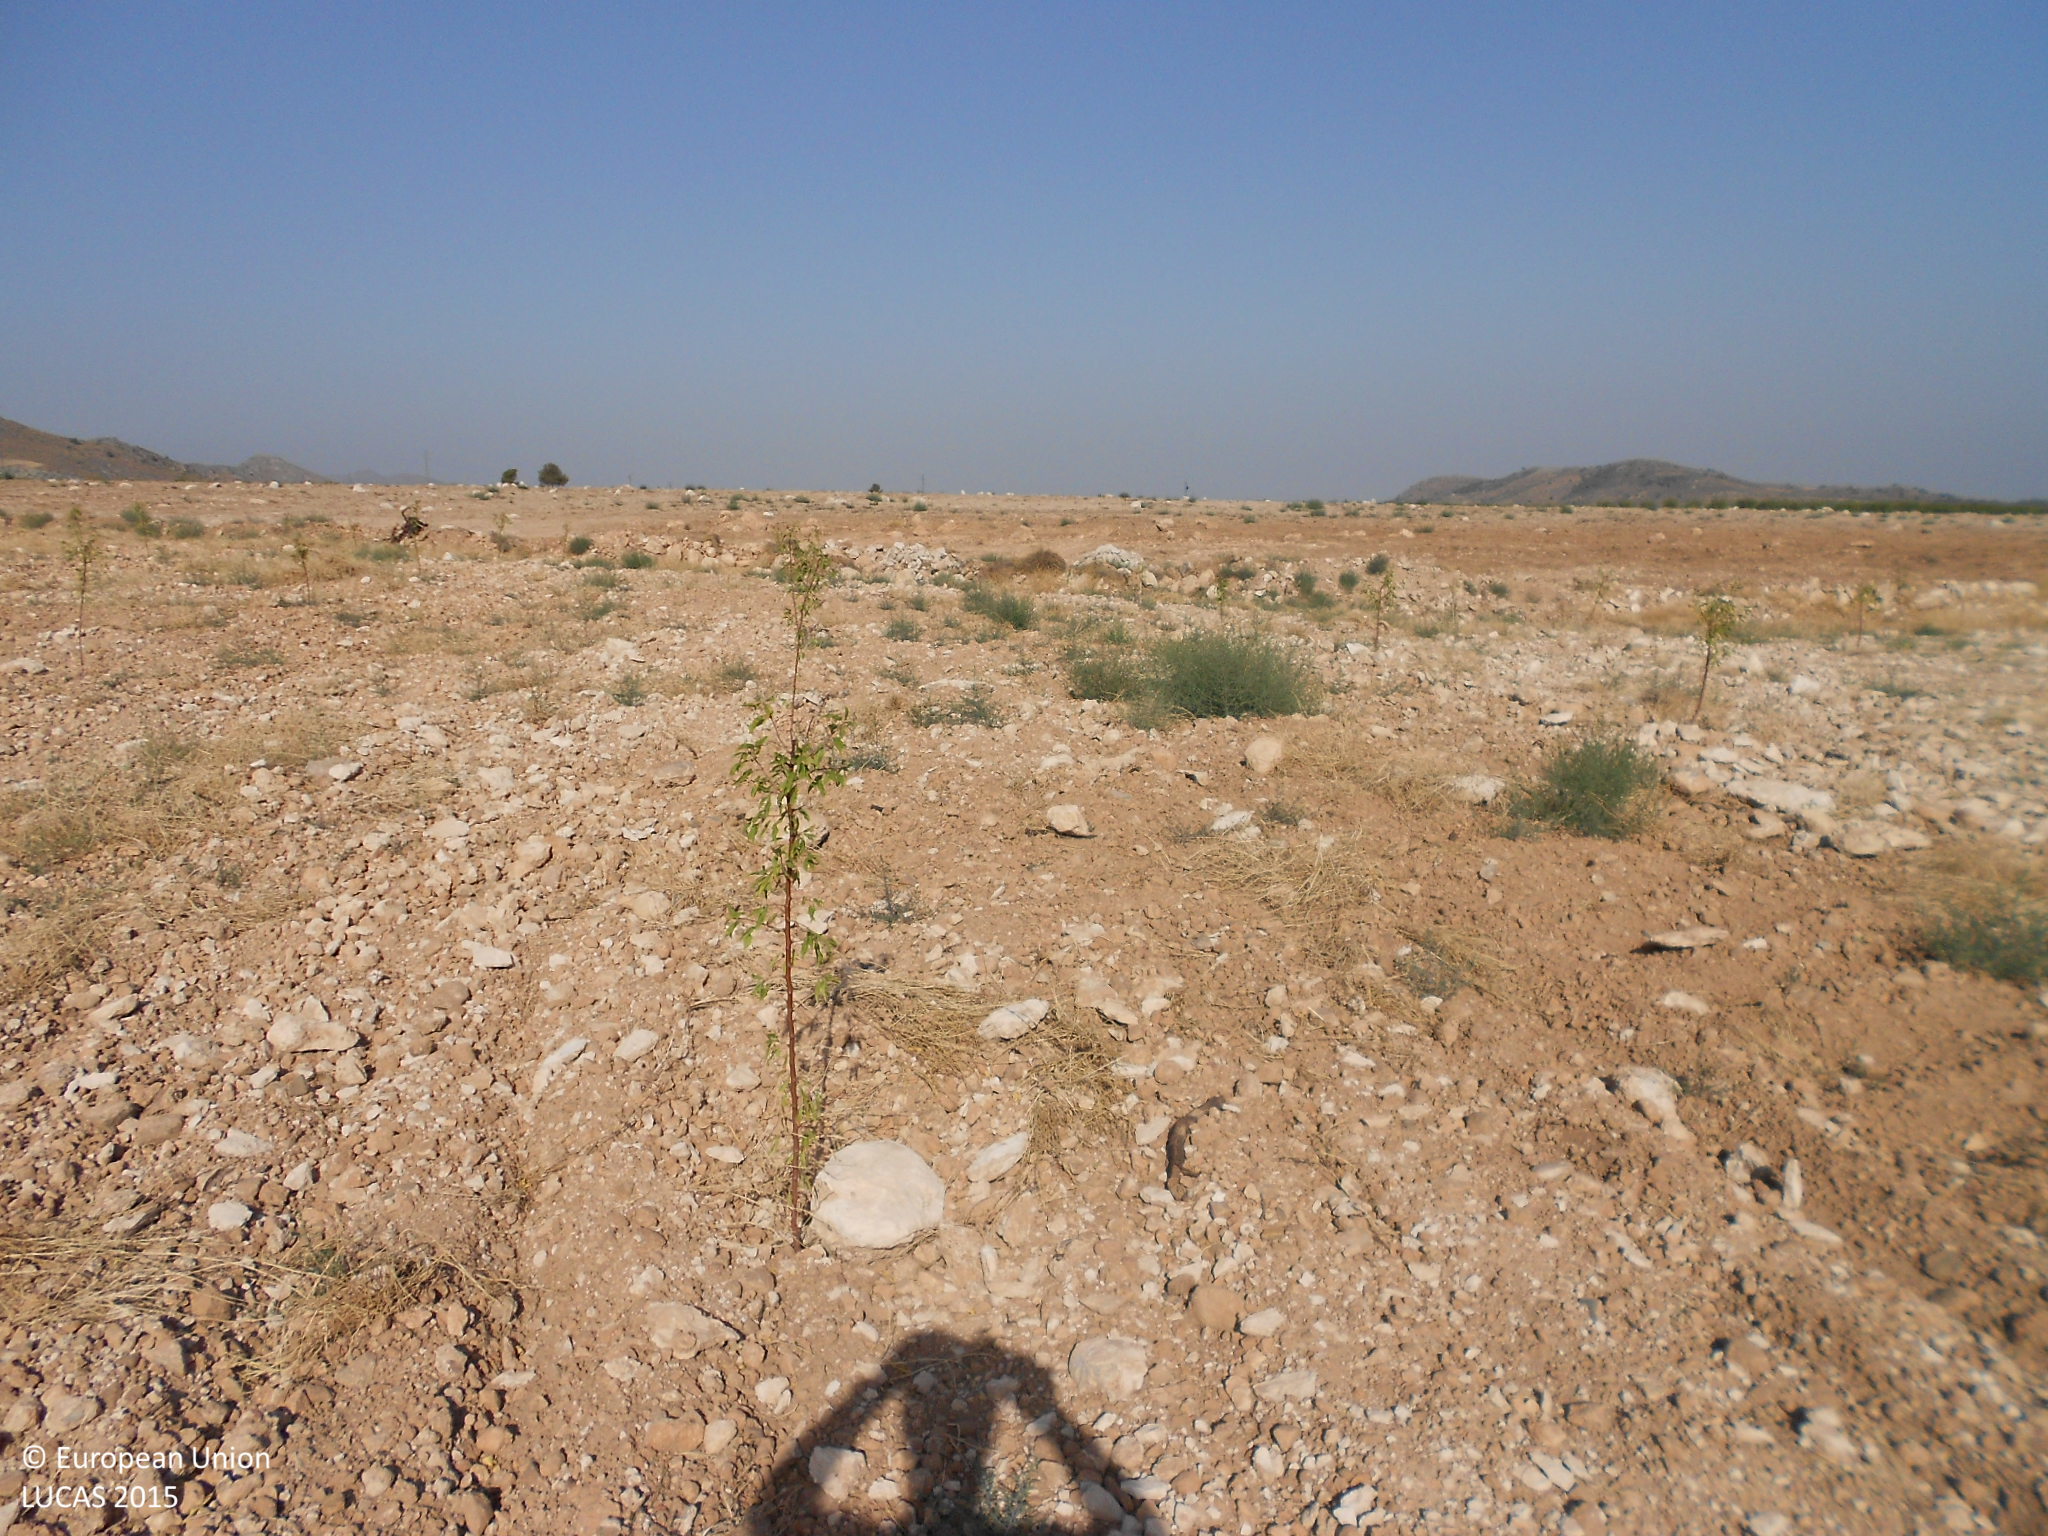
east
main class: Cropland
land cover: Nuts trees
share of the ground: < 10 %
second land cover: Other bare soil
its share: > 75 %
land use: Agriculture (excluding fallow land and kitchen gardens)
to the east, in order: Nuts trees; Other bare soil; Grass margins; Other bare soil
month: July
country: ES
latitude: 37.4716
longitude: -2.3425
